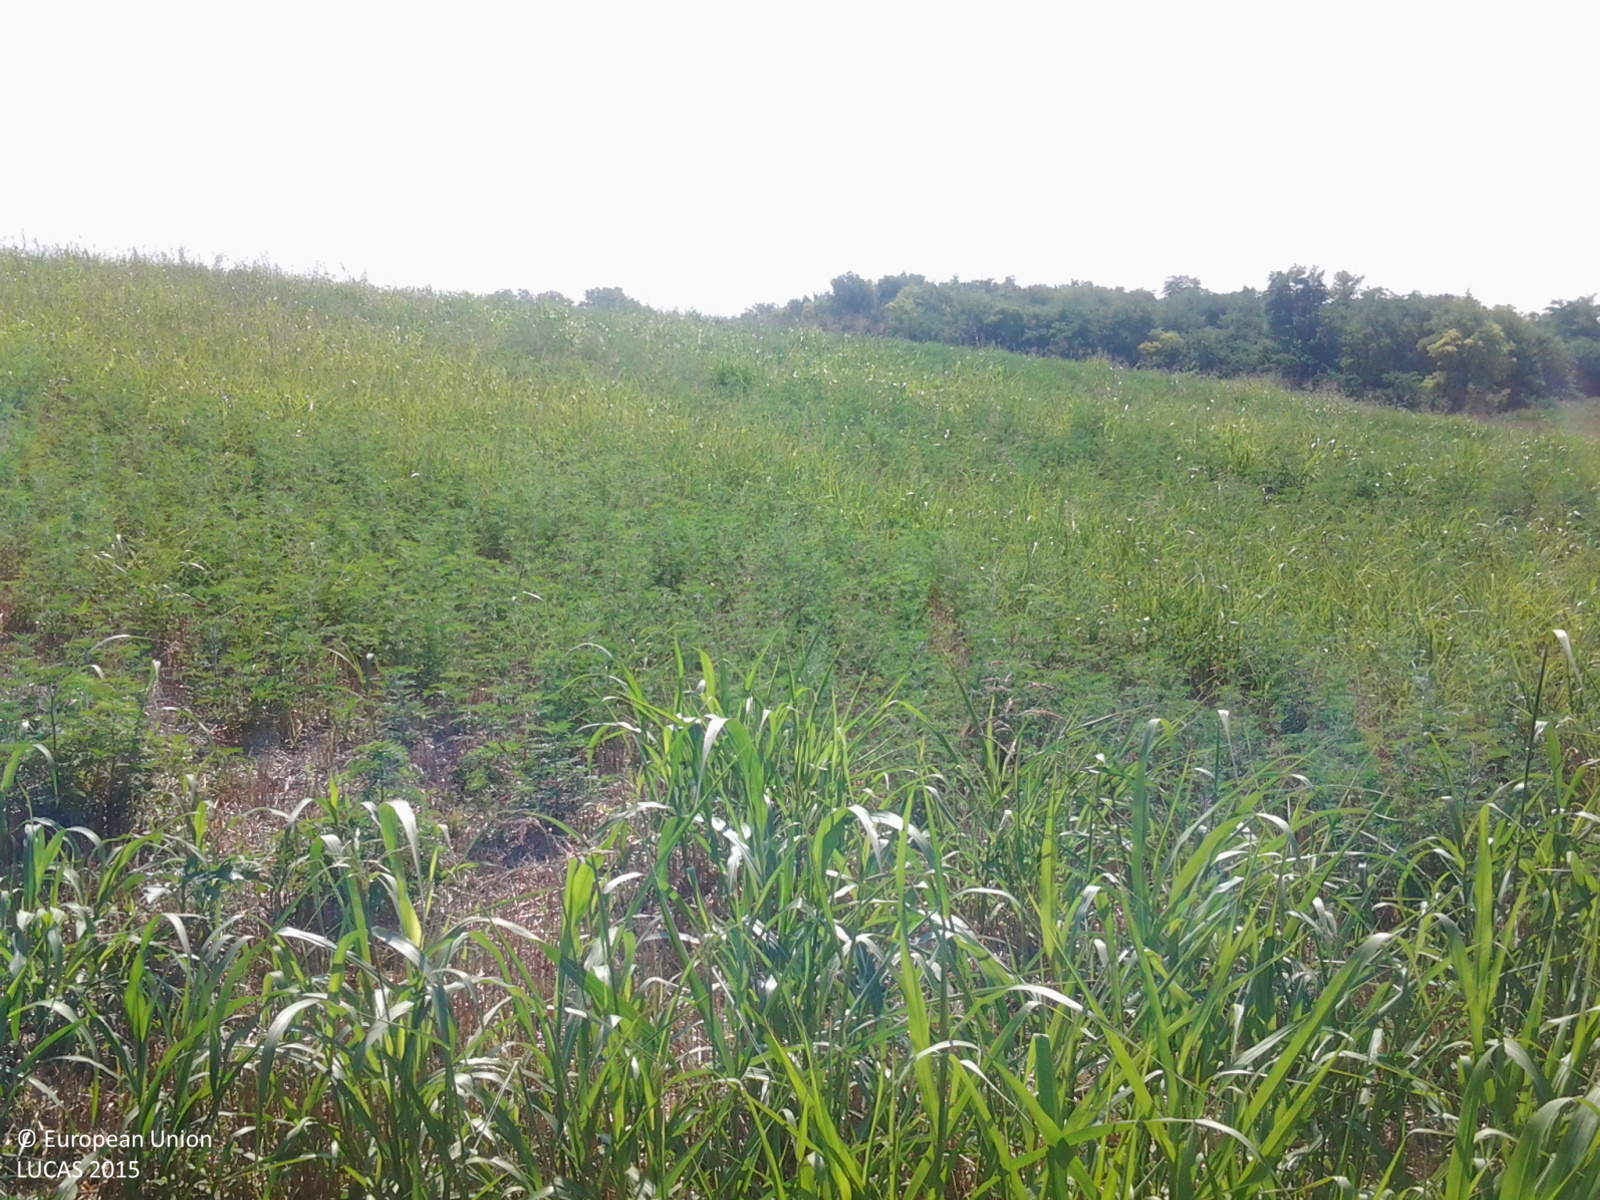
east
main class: Cropland
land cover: Common wheat
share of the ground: < 10 %
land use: Agriculture (excluding fallow land and kitchen gardens)
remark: Harvested field
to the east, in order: Common wheat; Spontaneously vegetated surfaces; Maize; Broadleaved woodland
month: August
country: HU
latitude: 46.7980
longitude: 18.4092
